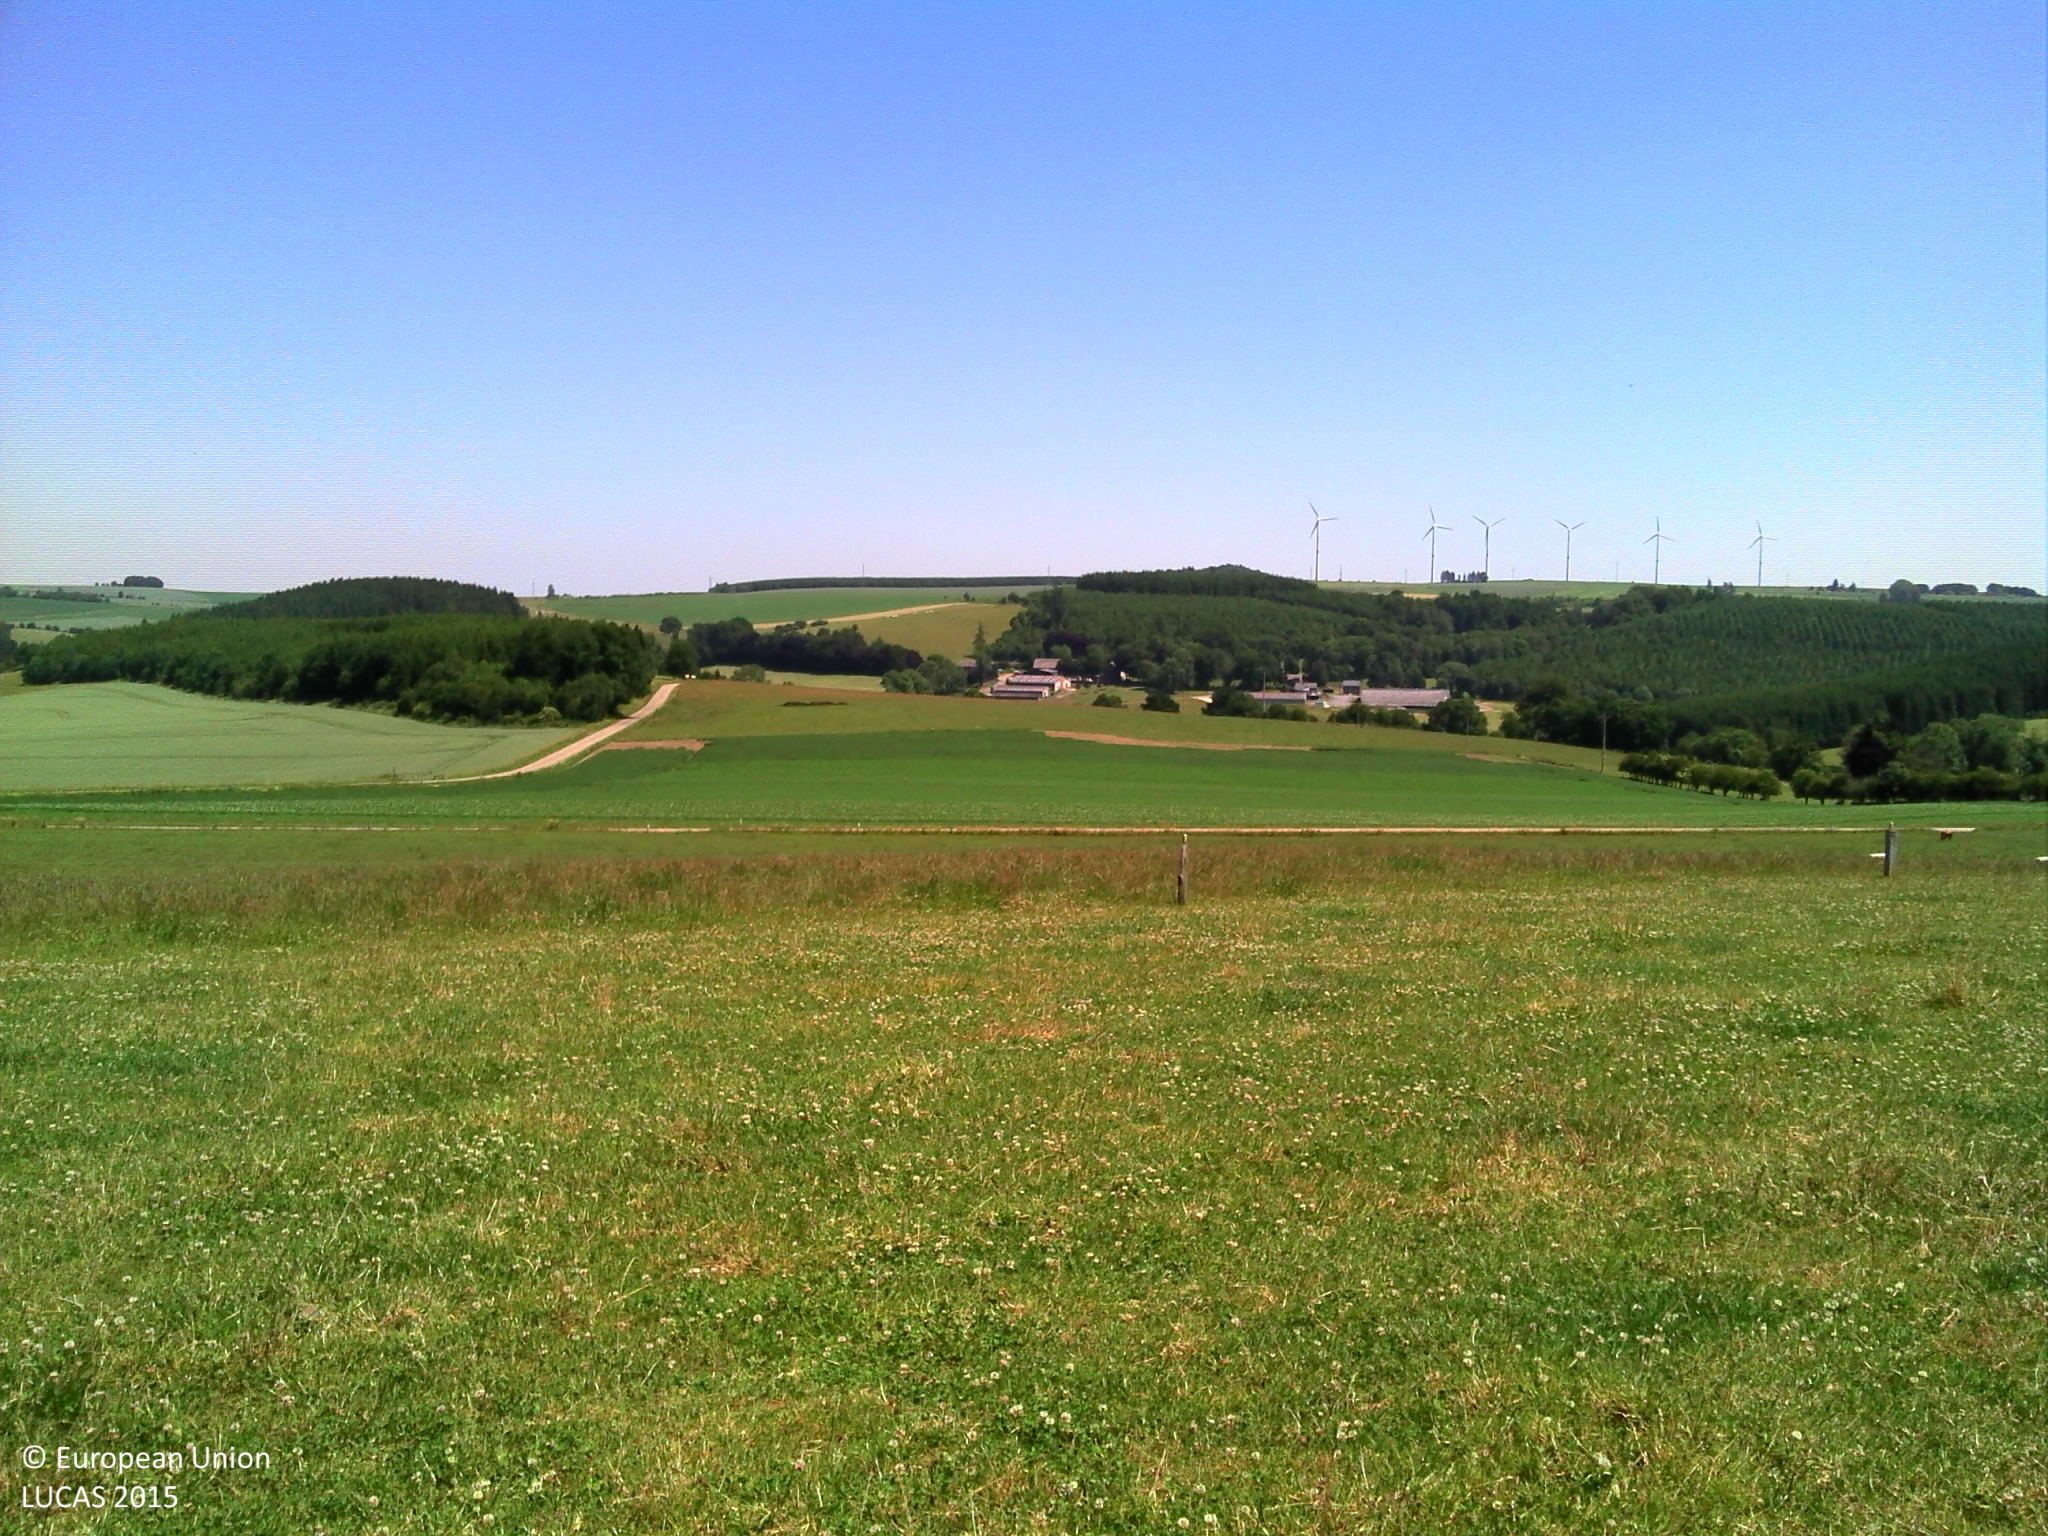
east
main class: Grassland
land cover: Grassland without tree/shrub cover
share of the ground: > 75 %
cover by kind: herbaceous plants 100 %
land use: Agriculture (excluding fallow land and kitchen gardens)
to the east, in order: Grassland without tree/shrub cover; Fences; Grassland without tree/shrub cover; Fences; Grass margins; Paved roads, cycling and walking lanes; Grass margins; Fences; Potatoes
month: June
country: BE
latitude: 50.0252
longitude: 5.5457
